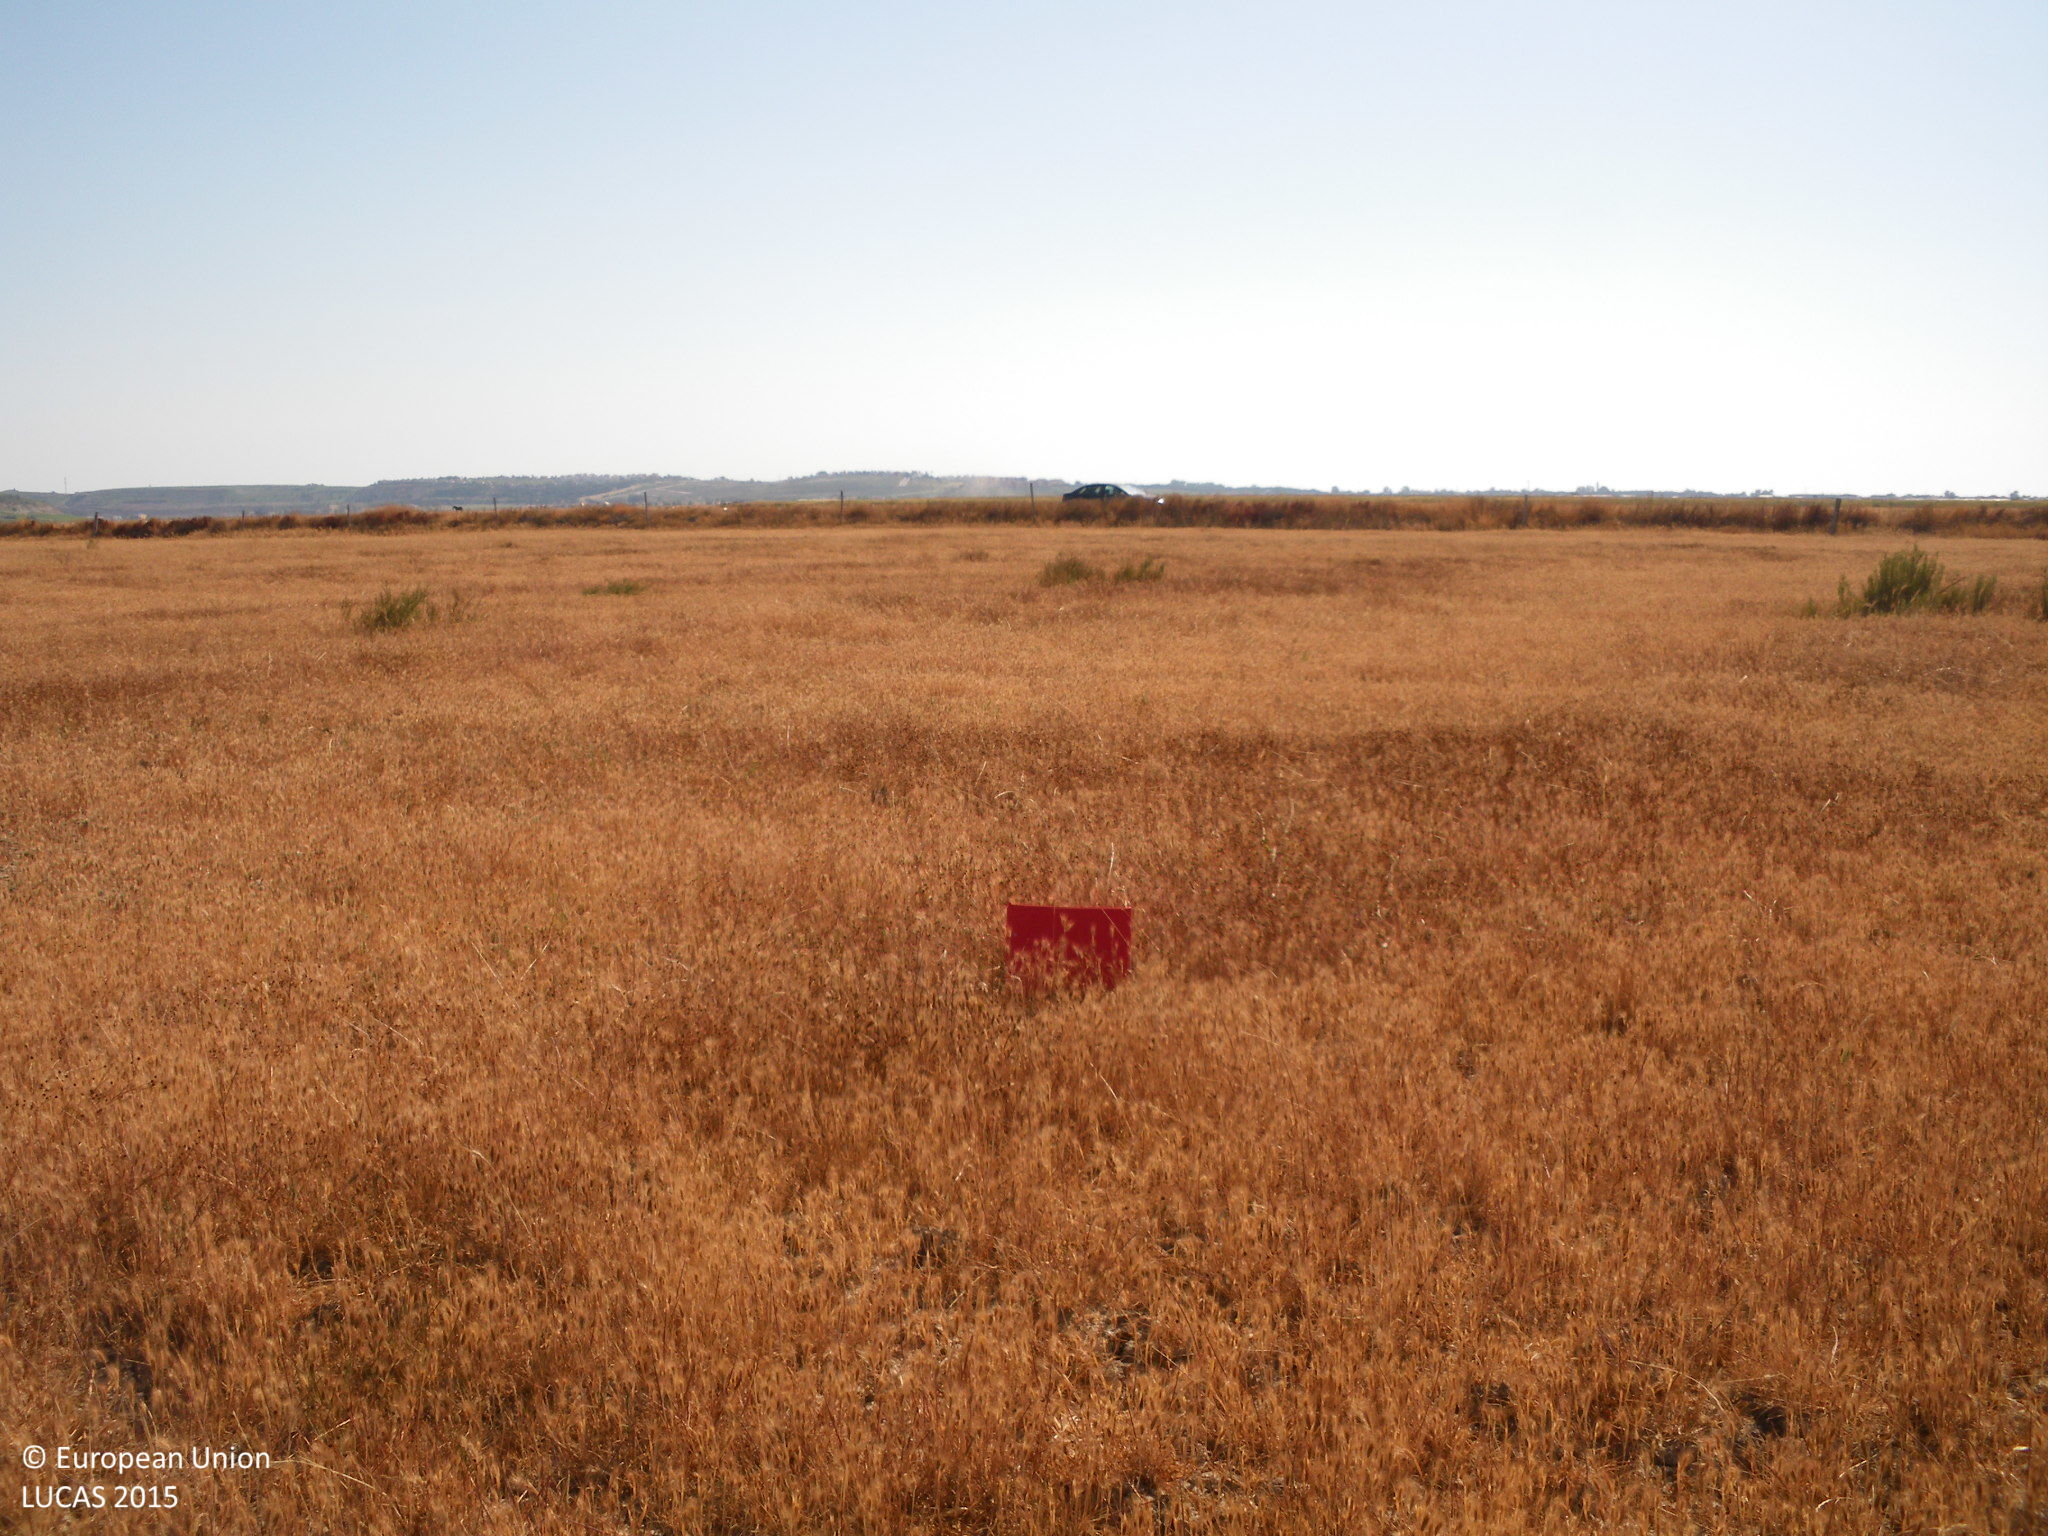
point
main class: Grassland
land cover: Spontaneously vegetated surfaces
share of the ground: > 75 %
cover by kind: herbaceous plants 100 %
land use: Agriculture (excluding fallow land and kitchen gardens)
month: May
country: ES
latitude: 36.8138
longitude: -6.2825
